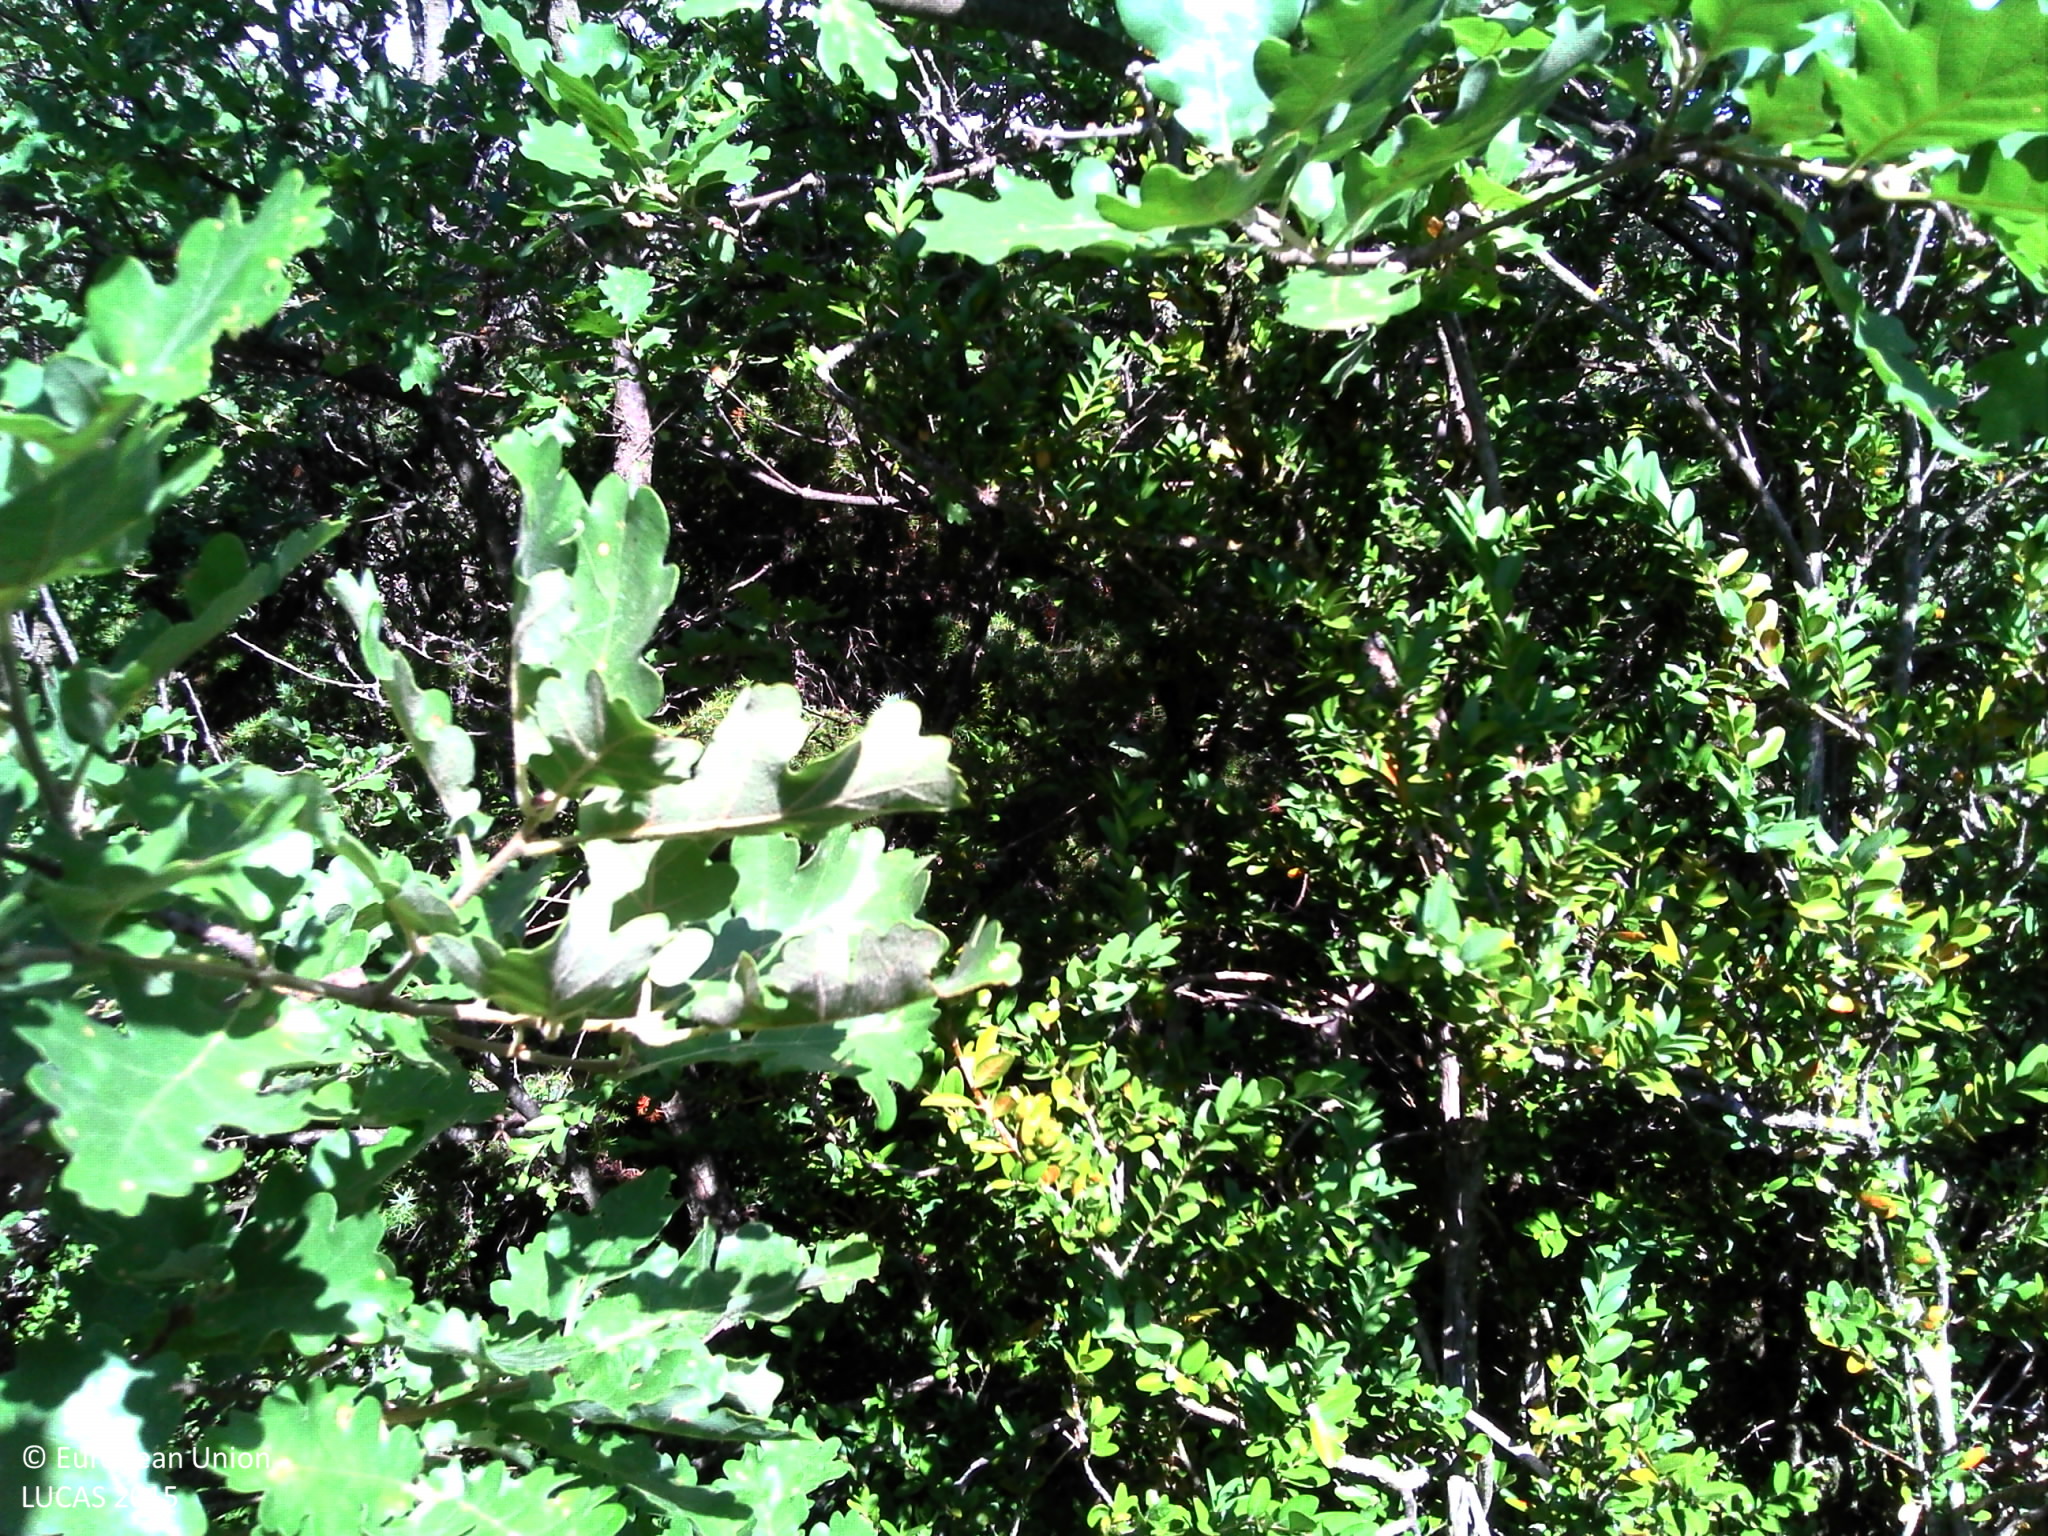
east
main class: Woodland
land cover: Broadleaved woodland
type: broadleaved evergreen forest
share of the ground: > 75 %
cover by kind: broadleaved forest trees 70 %, shrubs 15 %, coniferous forest trees 5 %, herbaceous plants 5 %, unconsolidated bare surface 5 %
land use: Forestry
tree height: < 5 m
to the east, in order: Broadleaved woodland; Tracks; Broadleaved woodland; Tracks; Broadleaved woodland; Rocks and stones; Shrubland with sparse tree cover; Pine dominated mixed woodland
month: July
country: FR
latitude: 43.9498
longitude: 5.1864
